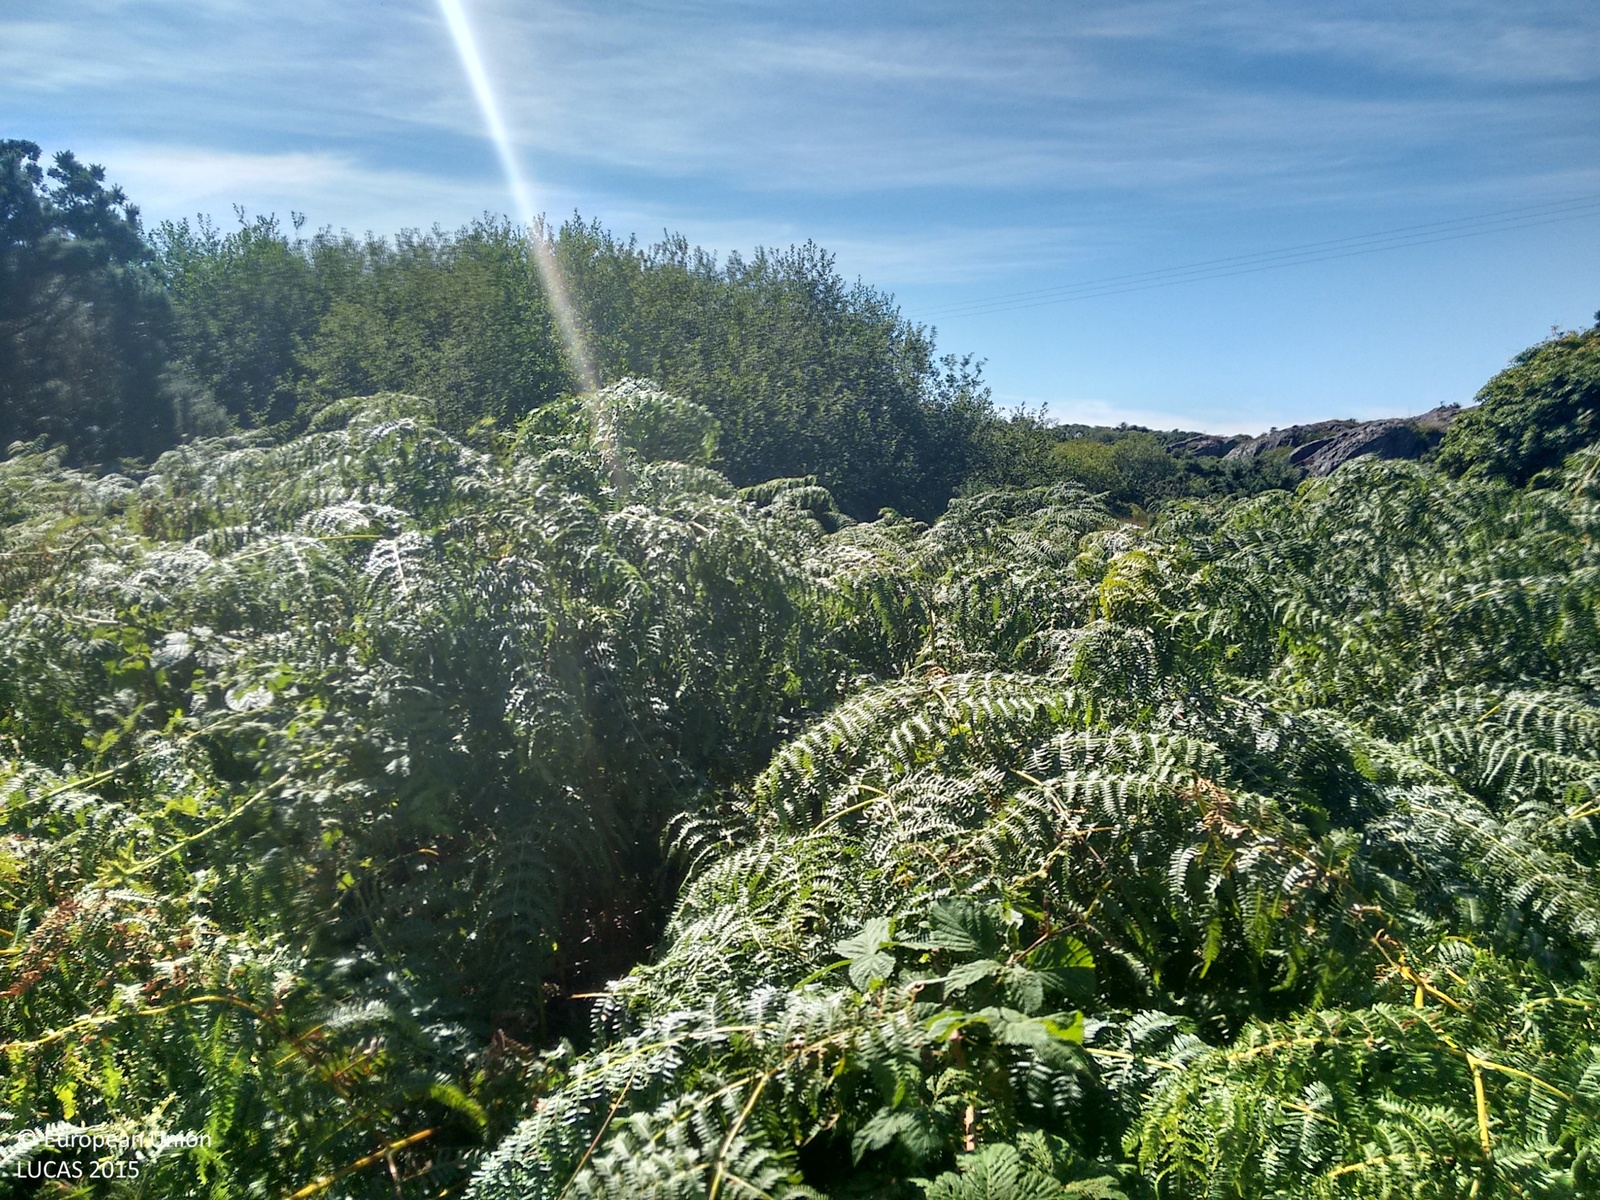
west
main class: Shrubland
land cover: Shrubland with sparse tree cover
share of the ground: > 75 %
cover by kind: shrubs 65 %, herbaceous plants 30 %, broadleaved forest trees 5 %
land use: Agriculture (excluding fallow land and kitchen gardens)
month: August
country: IE
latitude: 51.5759
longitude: -9.4659
